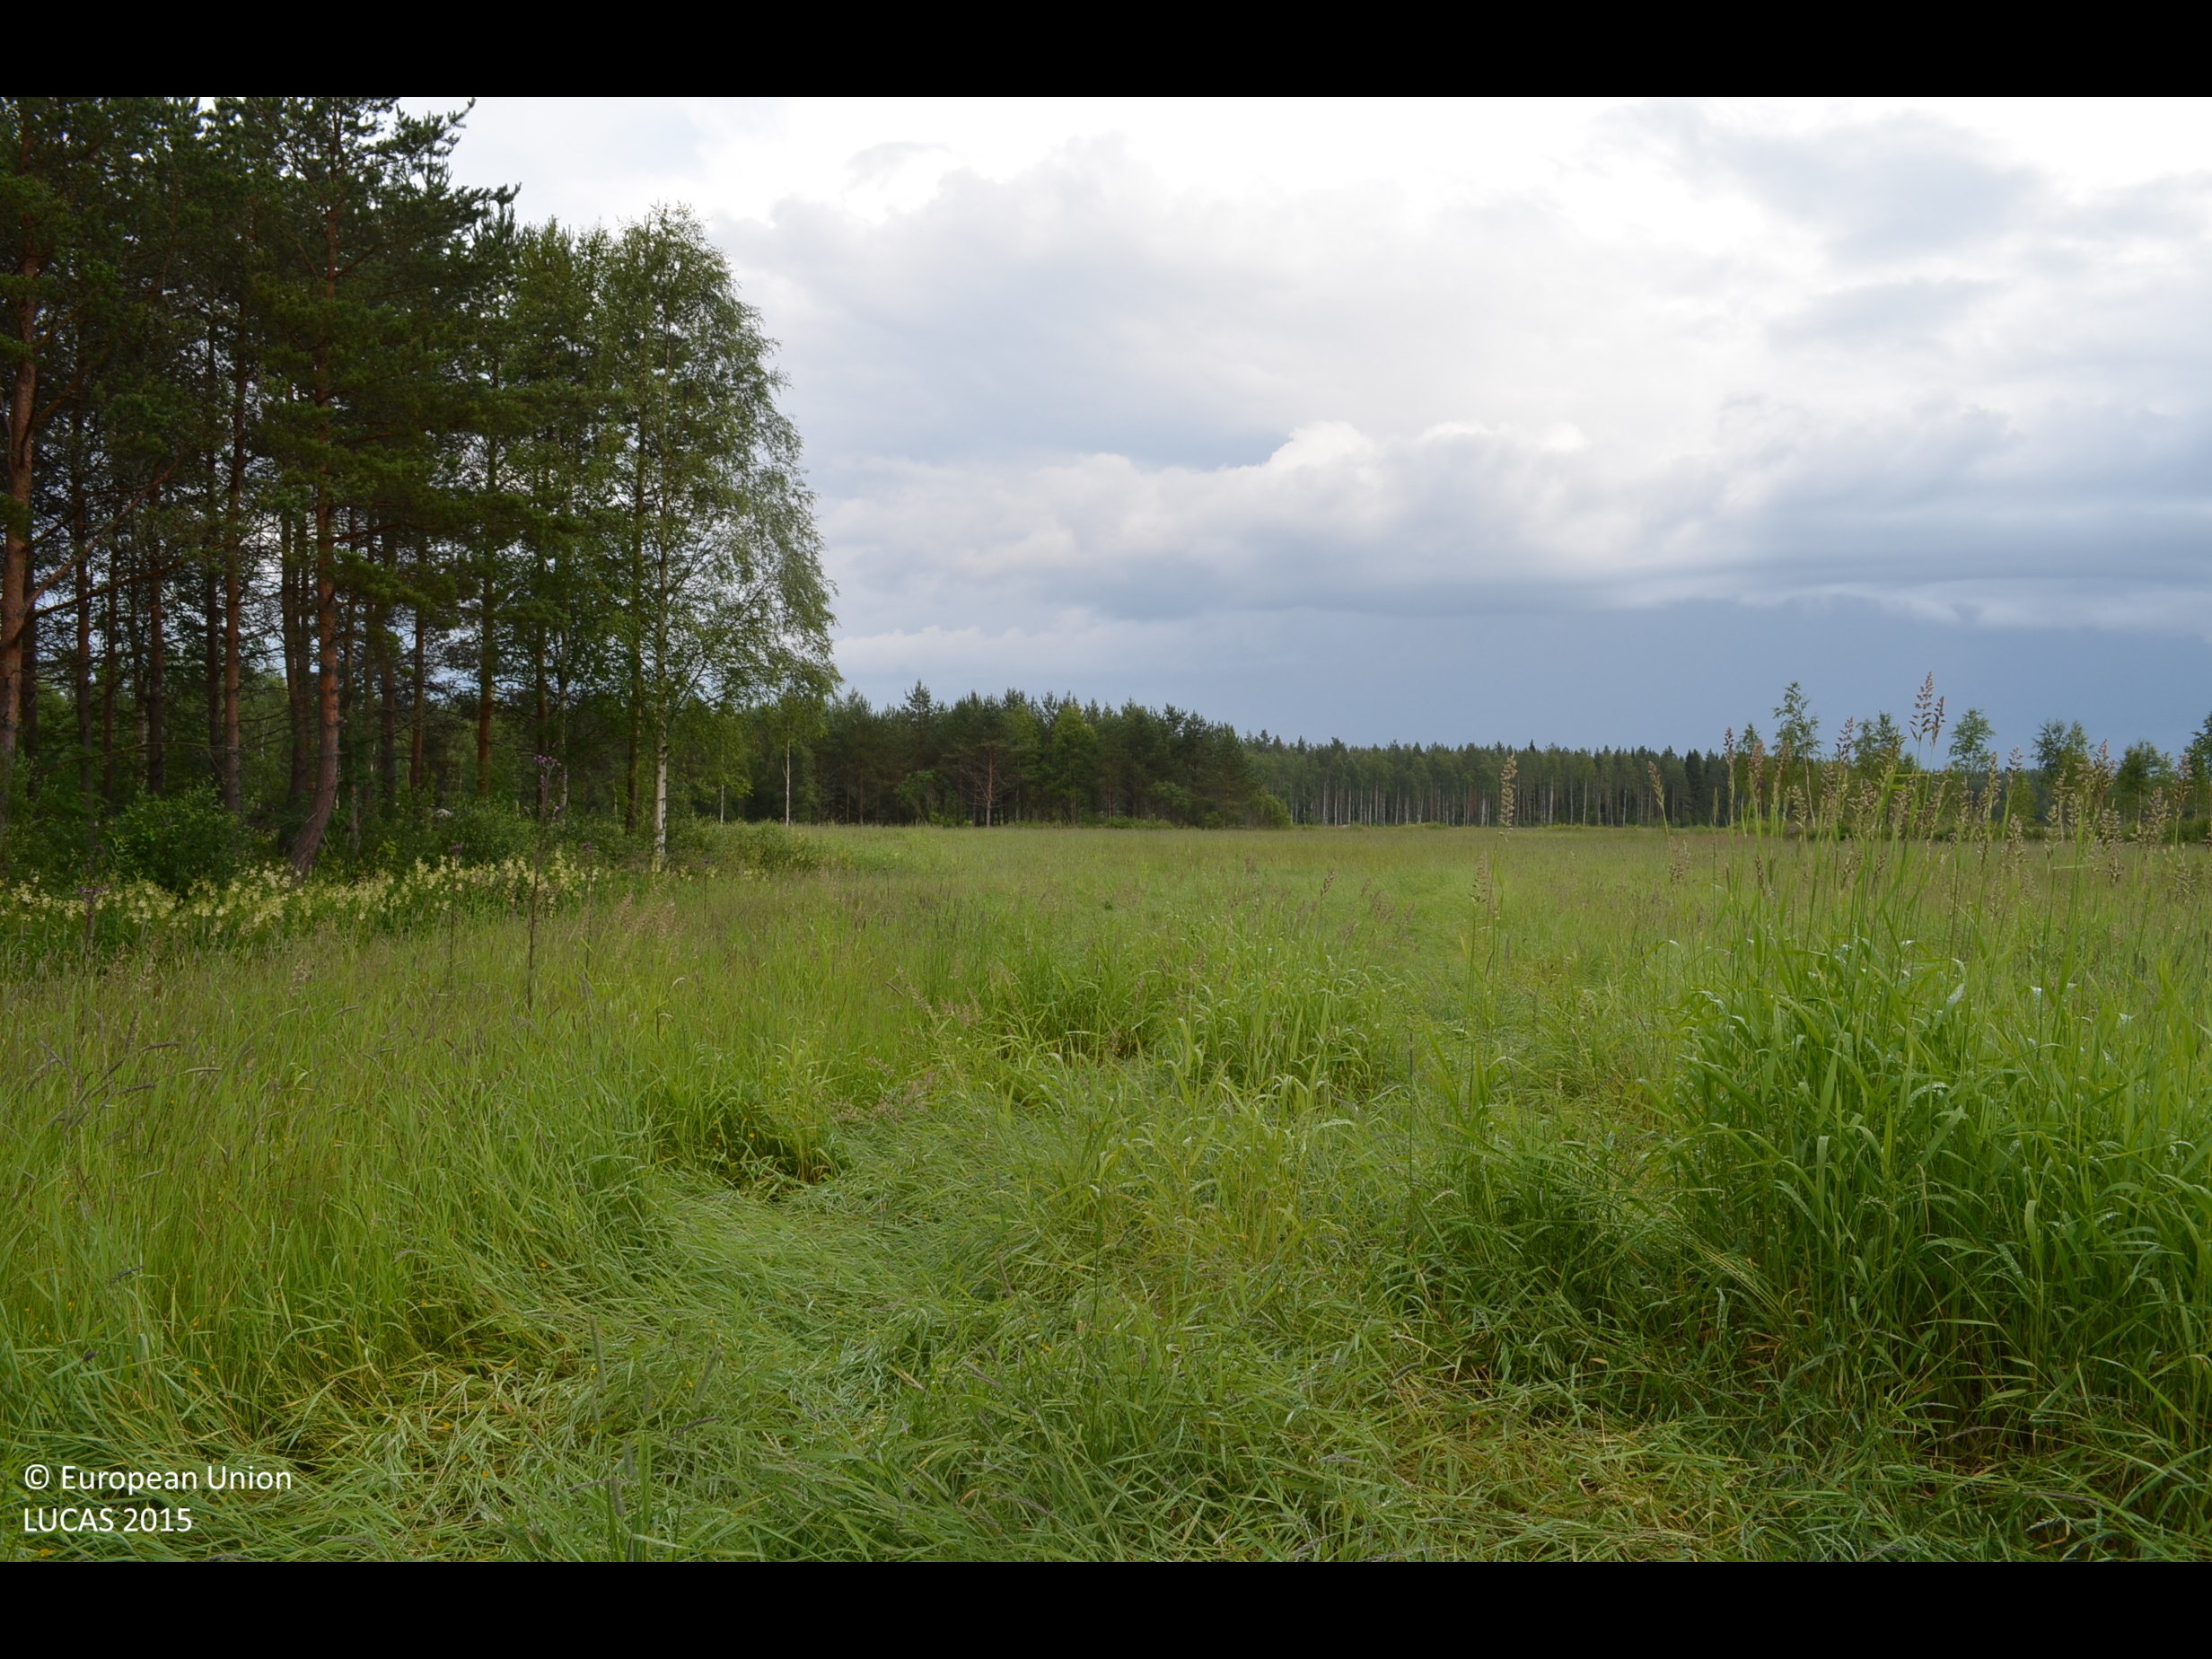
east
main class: Cropland
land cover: Temporary grasslands
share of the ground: > 75 %
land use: Agriculture (excluding fallow land and kitchen gardens)
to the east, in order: Temporary grasslands; Grass margins; Ditches and canals; Abandoned hedges; Ditches and canals; Abandoned hedges; Temporary grasslands; Other bare soil; Temporary grasslands; Grass margins; Ditches and canals; Abandoned hedges; Pine dominated mixed woodland; Ditches and canals; Pine dominated mixed woodland; Ditches and canals; Pine dominated mixed woodland; Ditches and canals; Abandoned hedges; Grassland without tree/shrub cover; Ditches and canals; Temporary grasslands
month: July
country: FI
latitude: 62.2893
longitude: 23.3521
